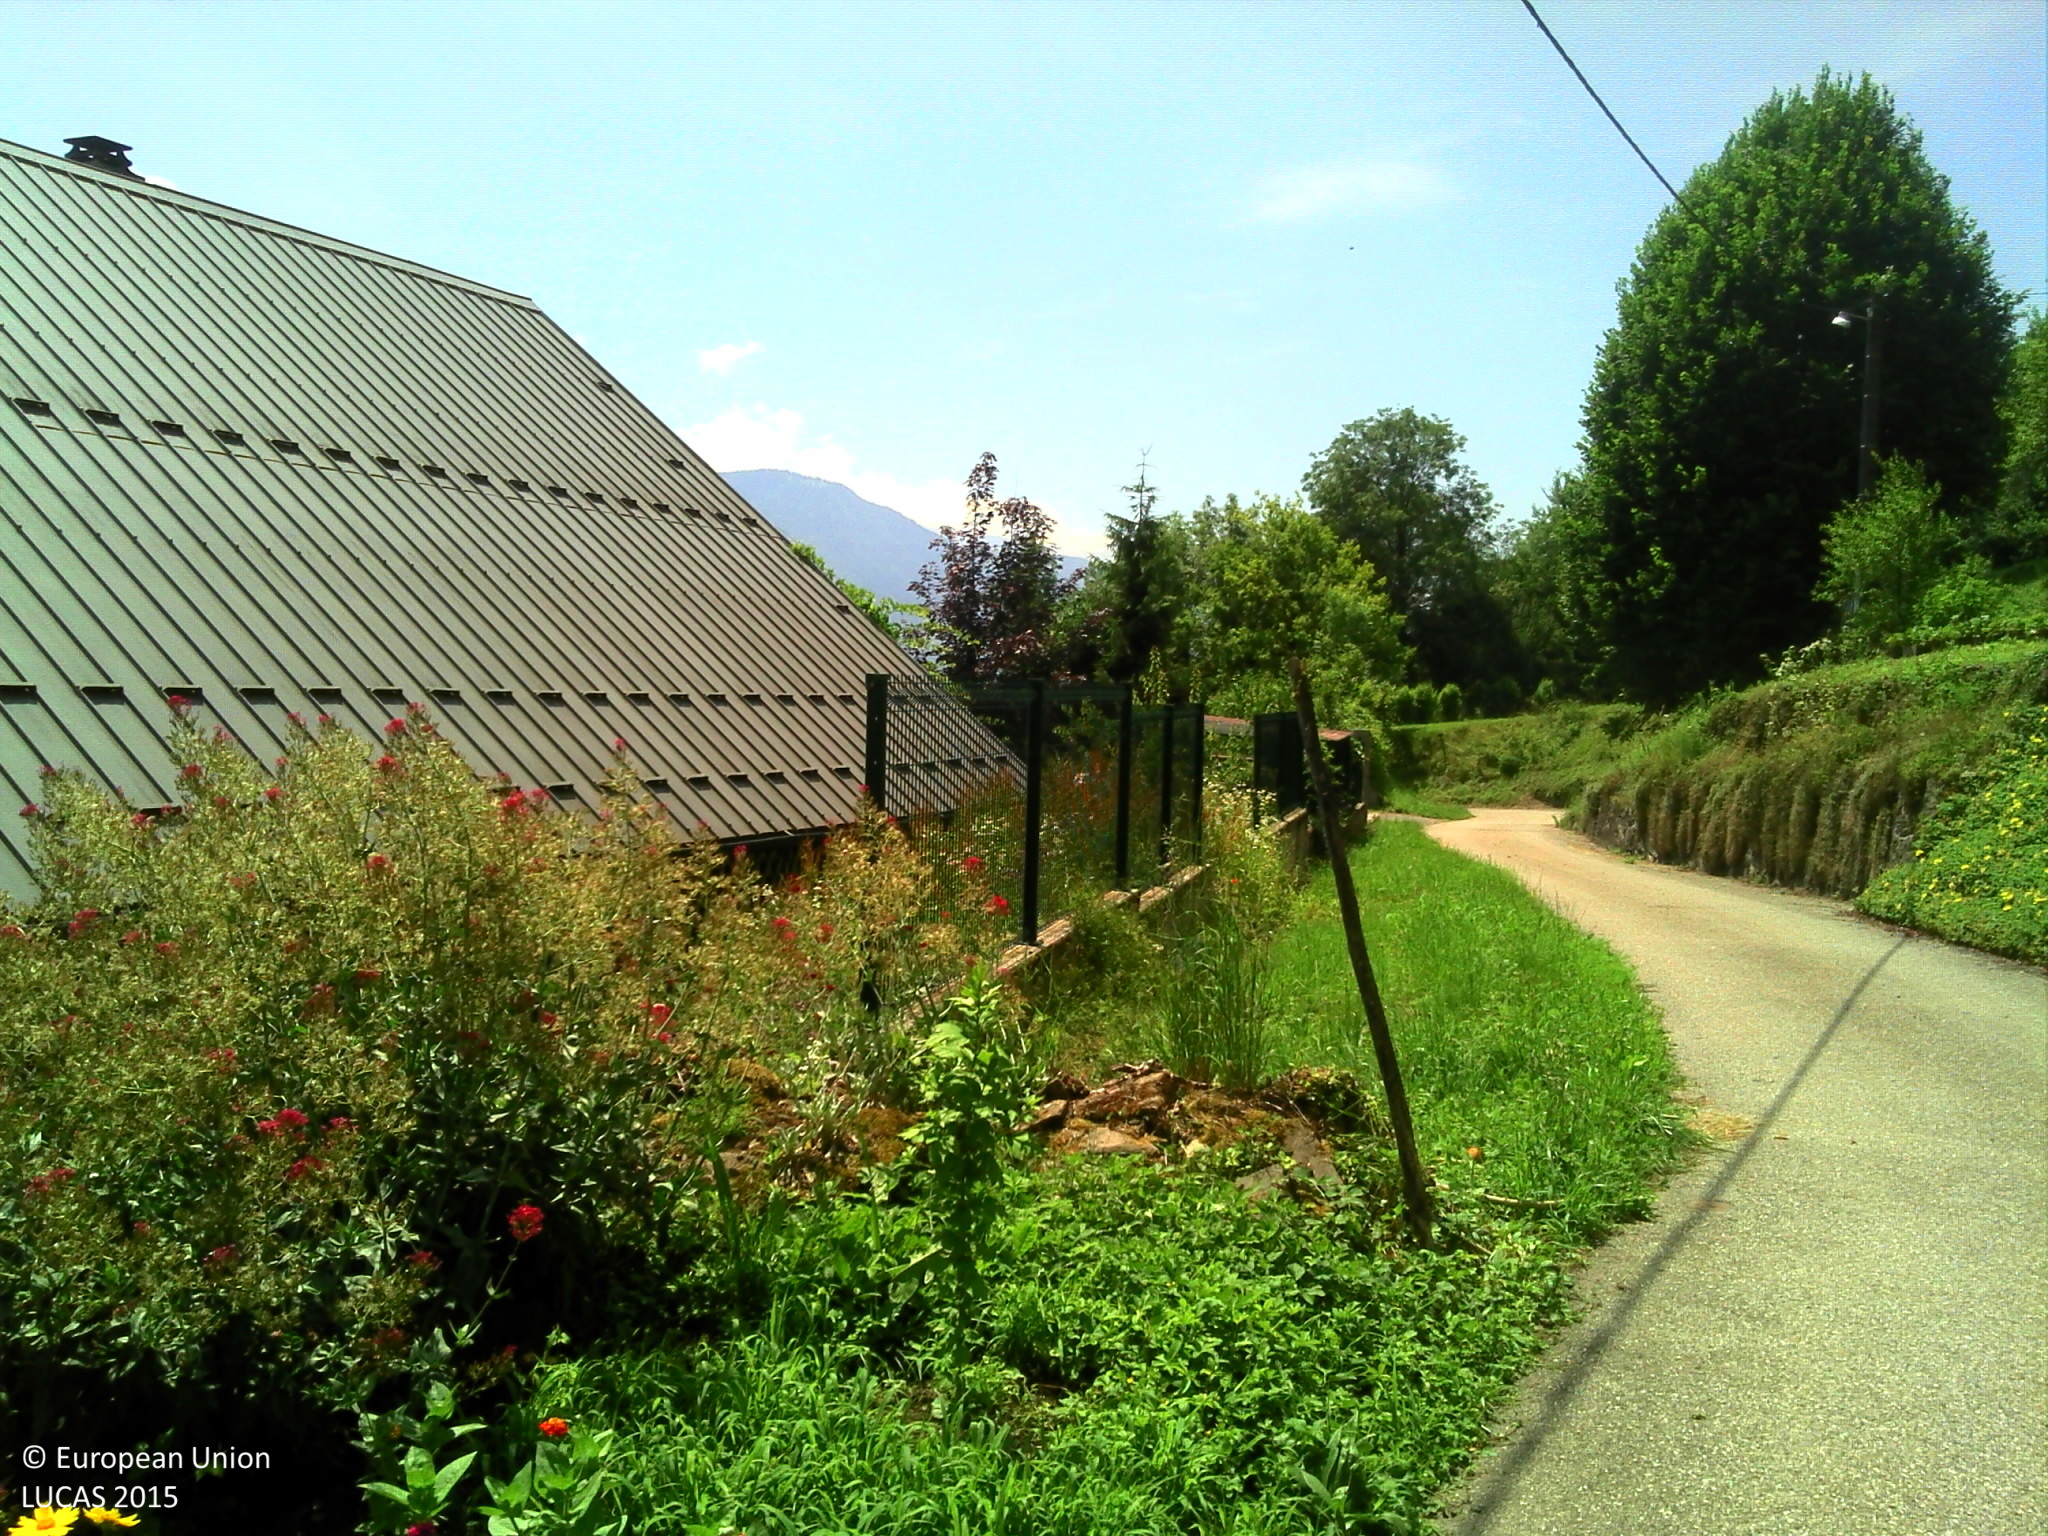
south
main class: Woodland
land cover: Broadleaved woodland
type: mountainous beech forest
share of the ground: > 75 %
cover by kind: broadleaved forest trees 100 %
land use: Forestry
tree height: > 5 m
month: June
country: FR
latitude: 45.5992
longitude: 6.2225
